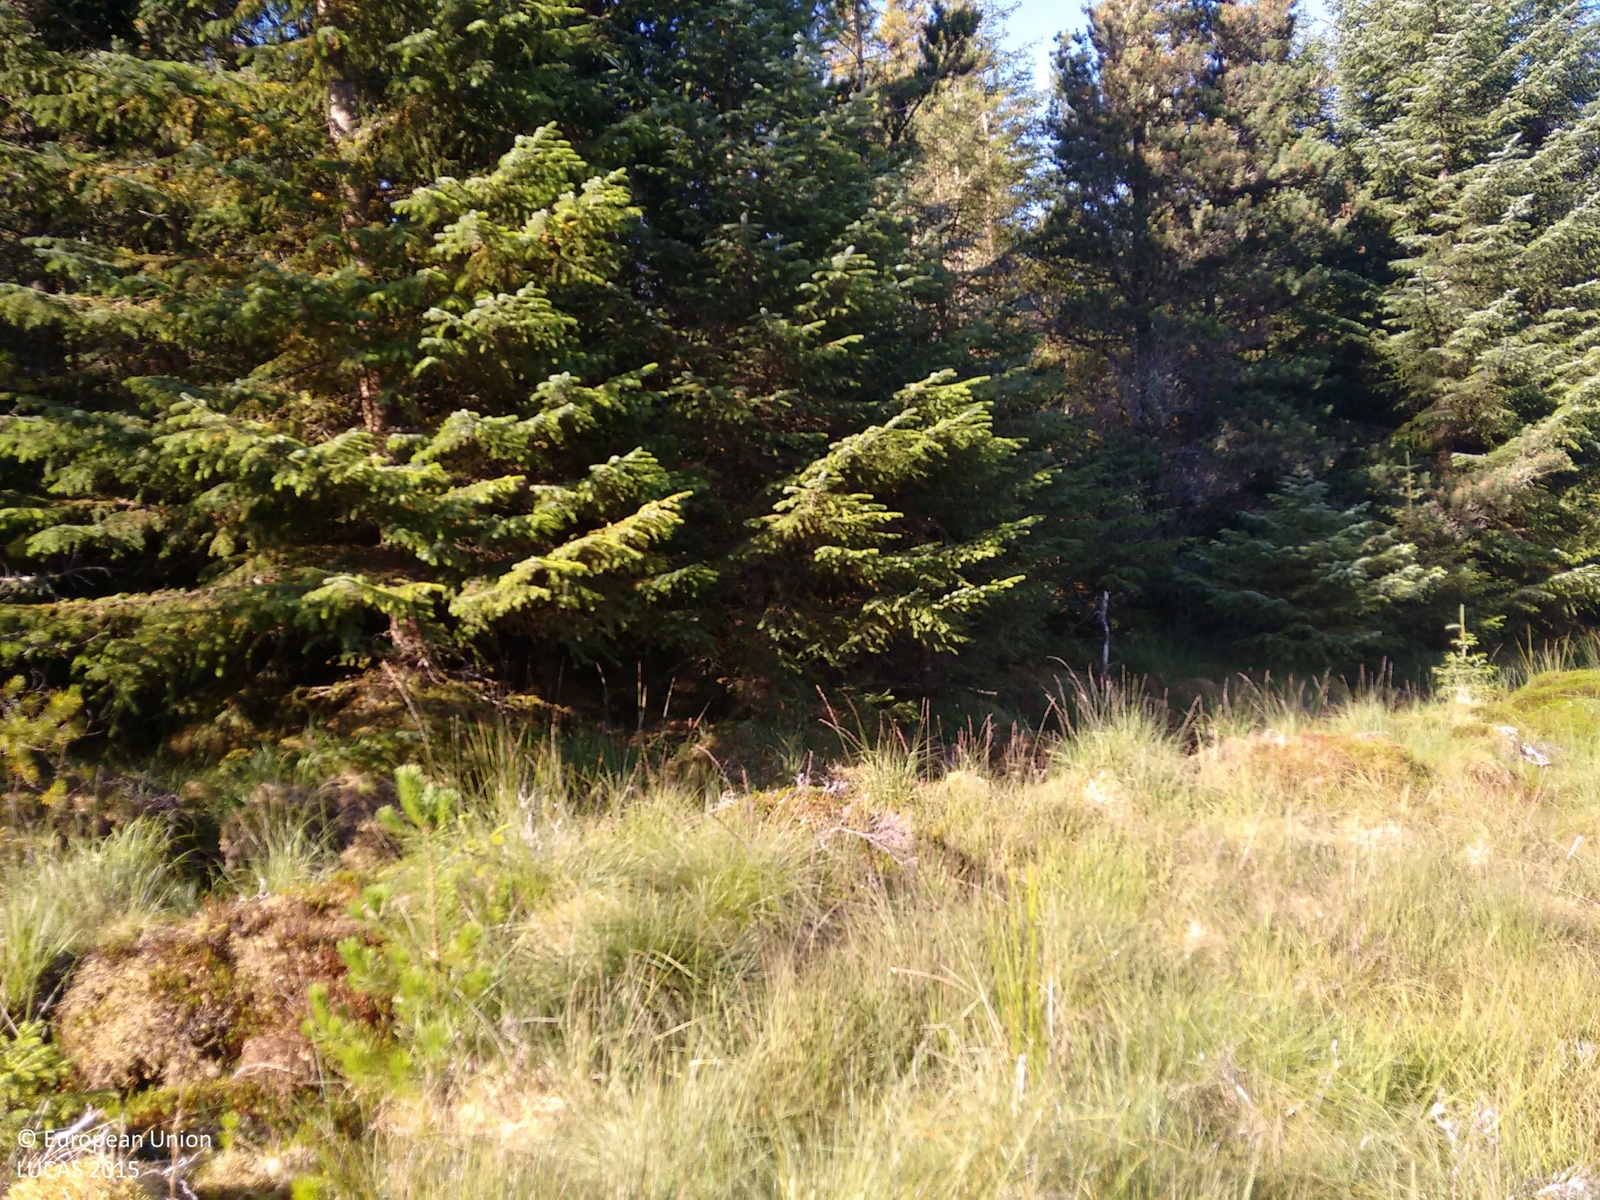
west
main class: Grassland
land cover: Grassland without tree/shrub cover
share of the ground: > 75 %
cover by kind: herbaceous plants 90 %, lichens and mosses 10 %
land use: Forestry
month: September
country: GB
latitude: 58.0127
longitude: -4.8377
